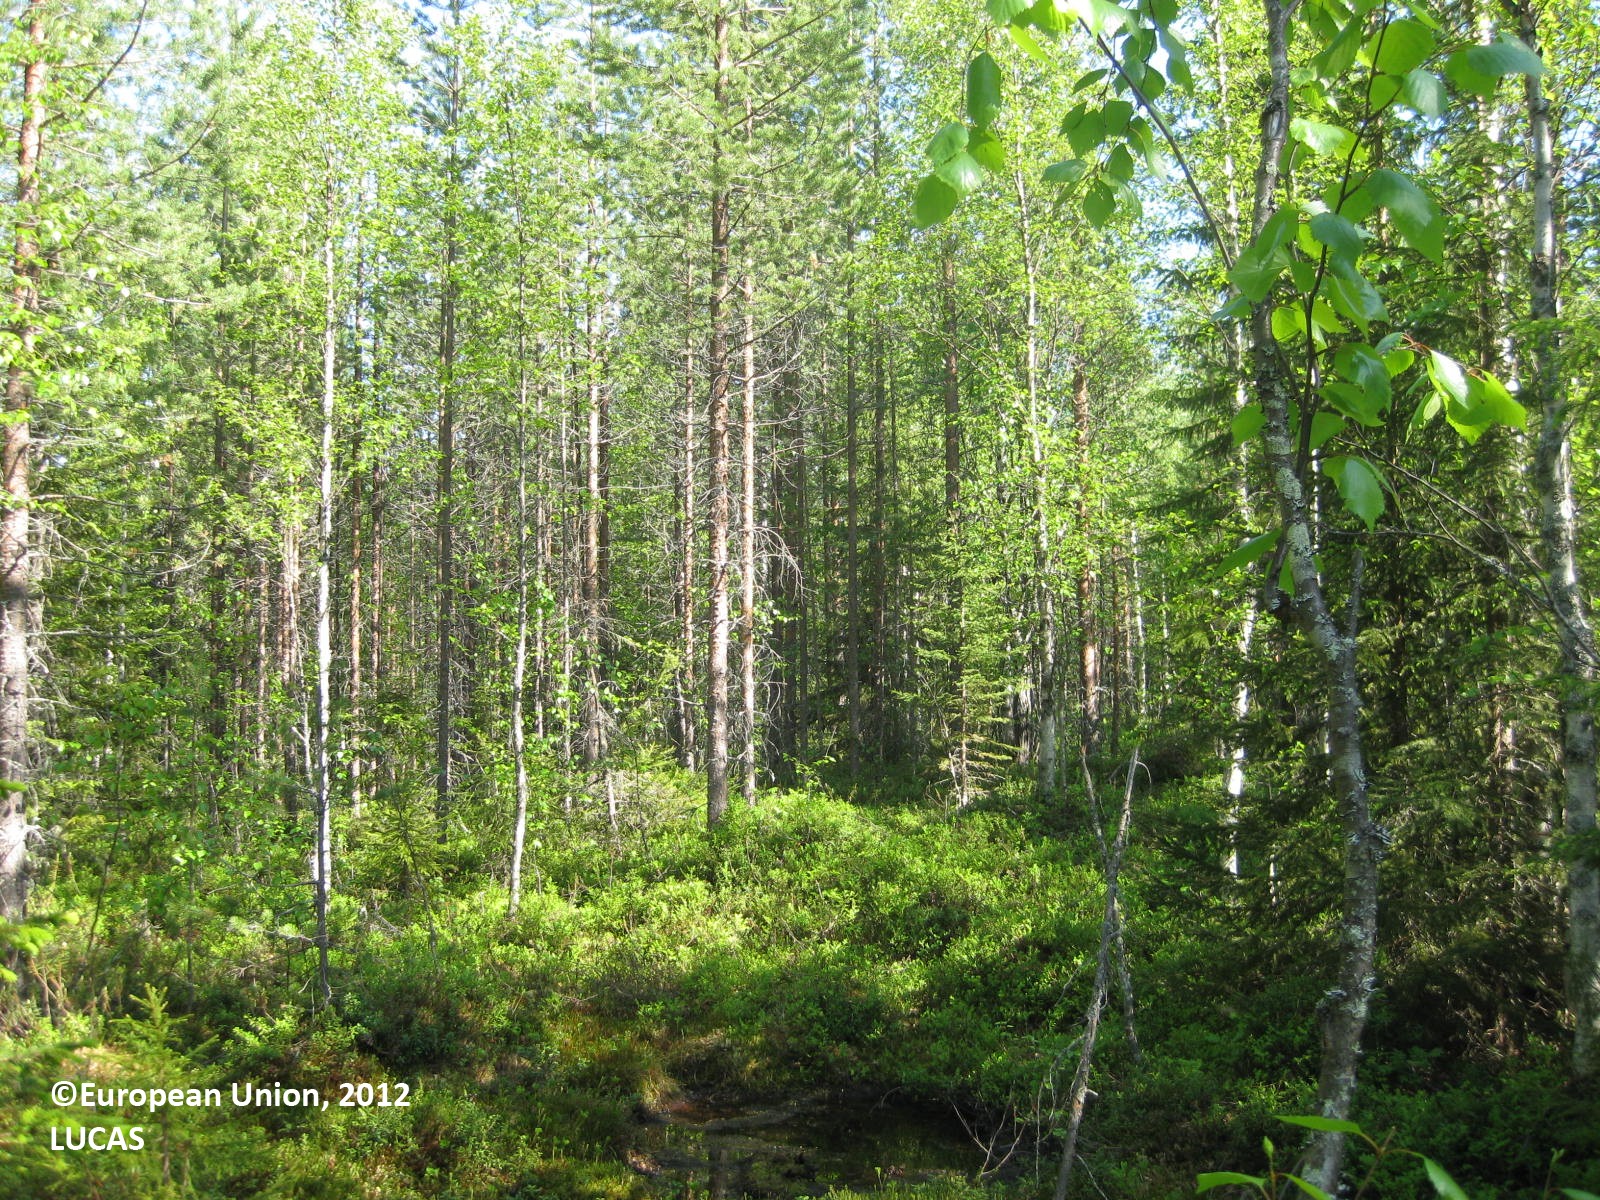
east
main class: Woodland
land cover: Pine dominated mixed woodland
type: boreal forest
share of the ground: > 75 %
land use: Forestry
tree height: > 5 m
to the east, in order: Pine dominated mixed woodland; Other mixed woodland; Pine dominated mixed woodland; Other mixed woodland
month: June
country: FI
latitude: 65.0567
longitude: 29.0818
